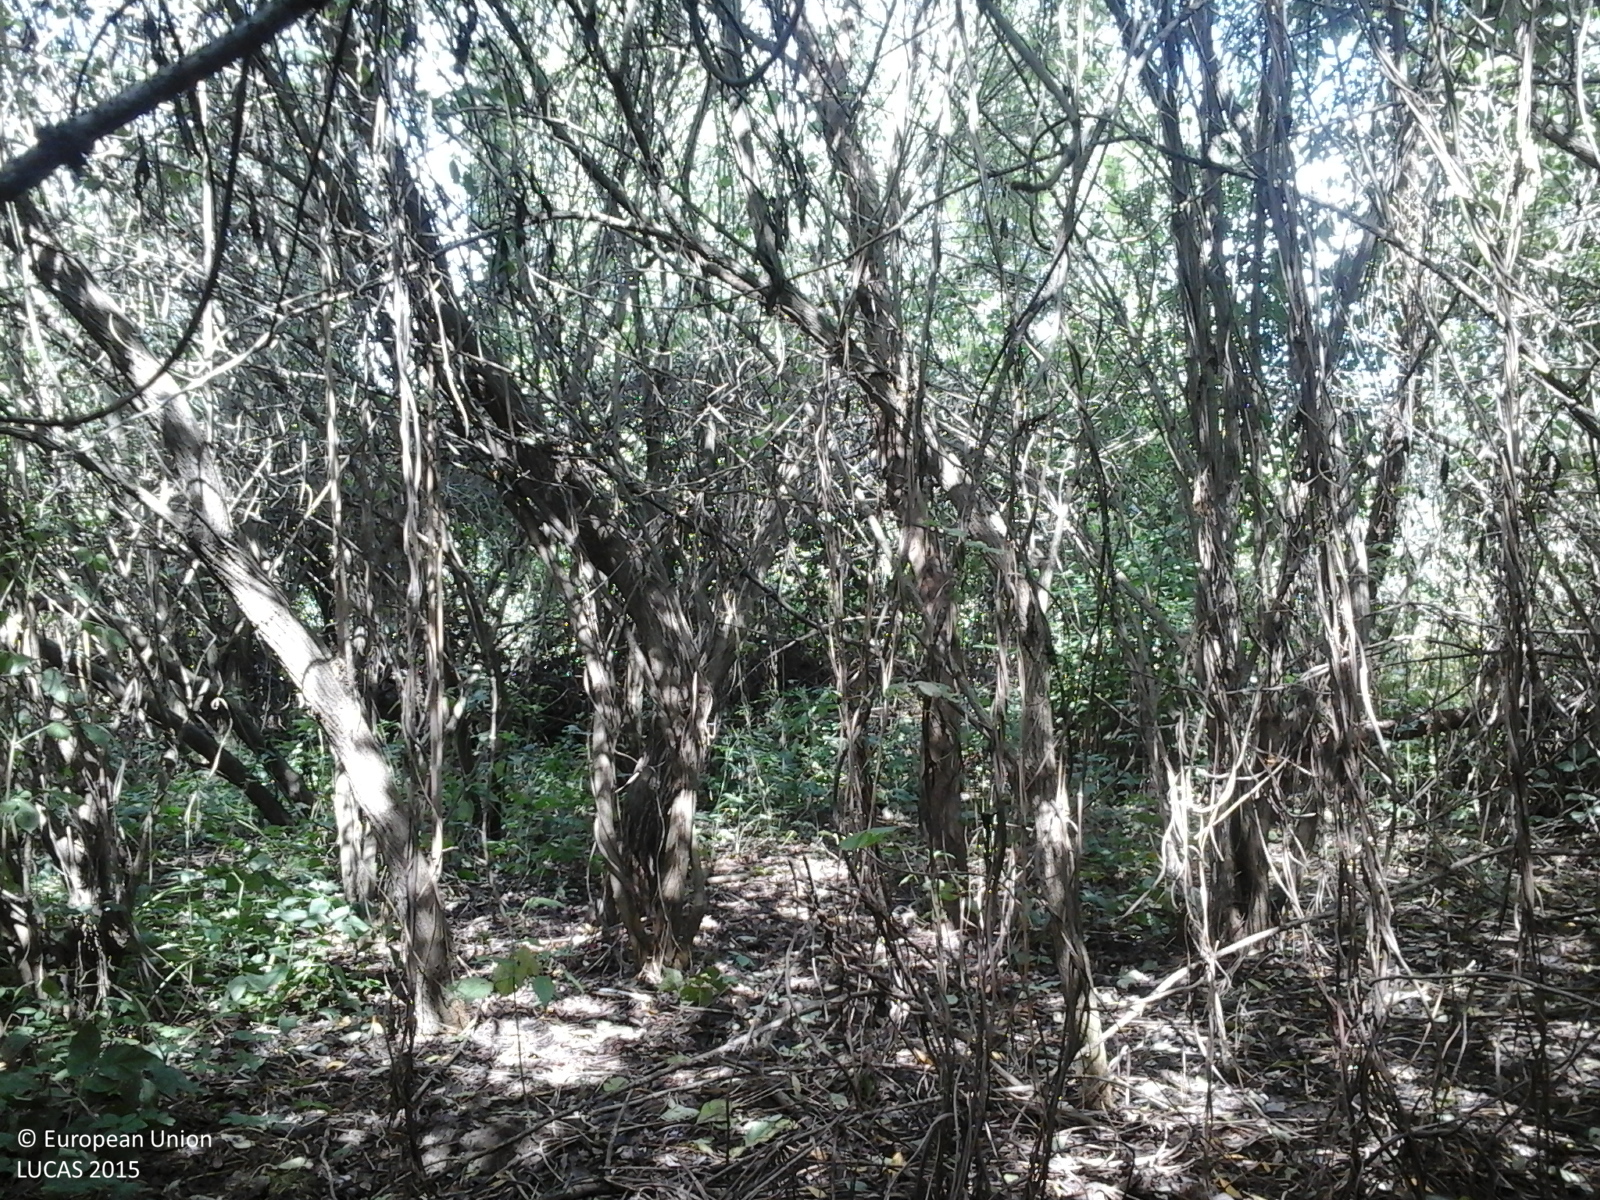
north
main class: Woodland
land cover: Broadleaved woodland
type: non-riverine alder, birch or aspen forest
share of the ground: > 75 %
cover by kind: broadleaved forest trees 100 %
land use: Forestry
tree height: > 5 m
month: September
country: RO
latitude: 47.3364
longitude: 23.4788
